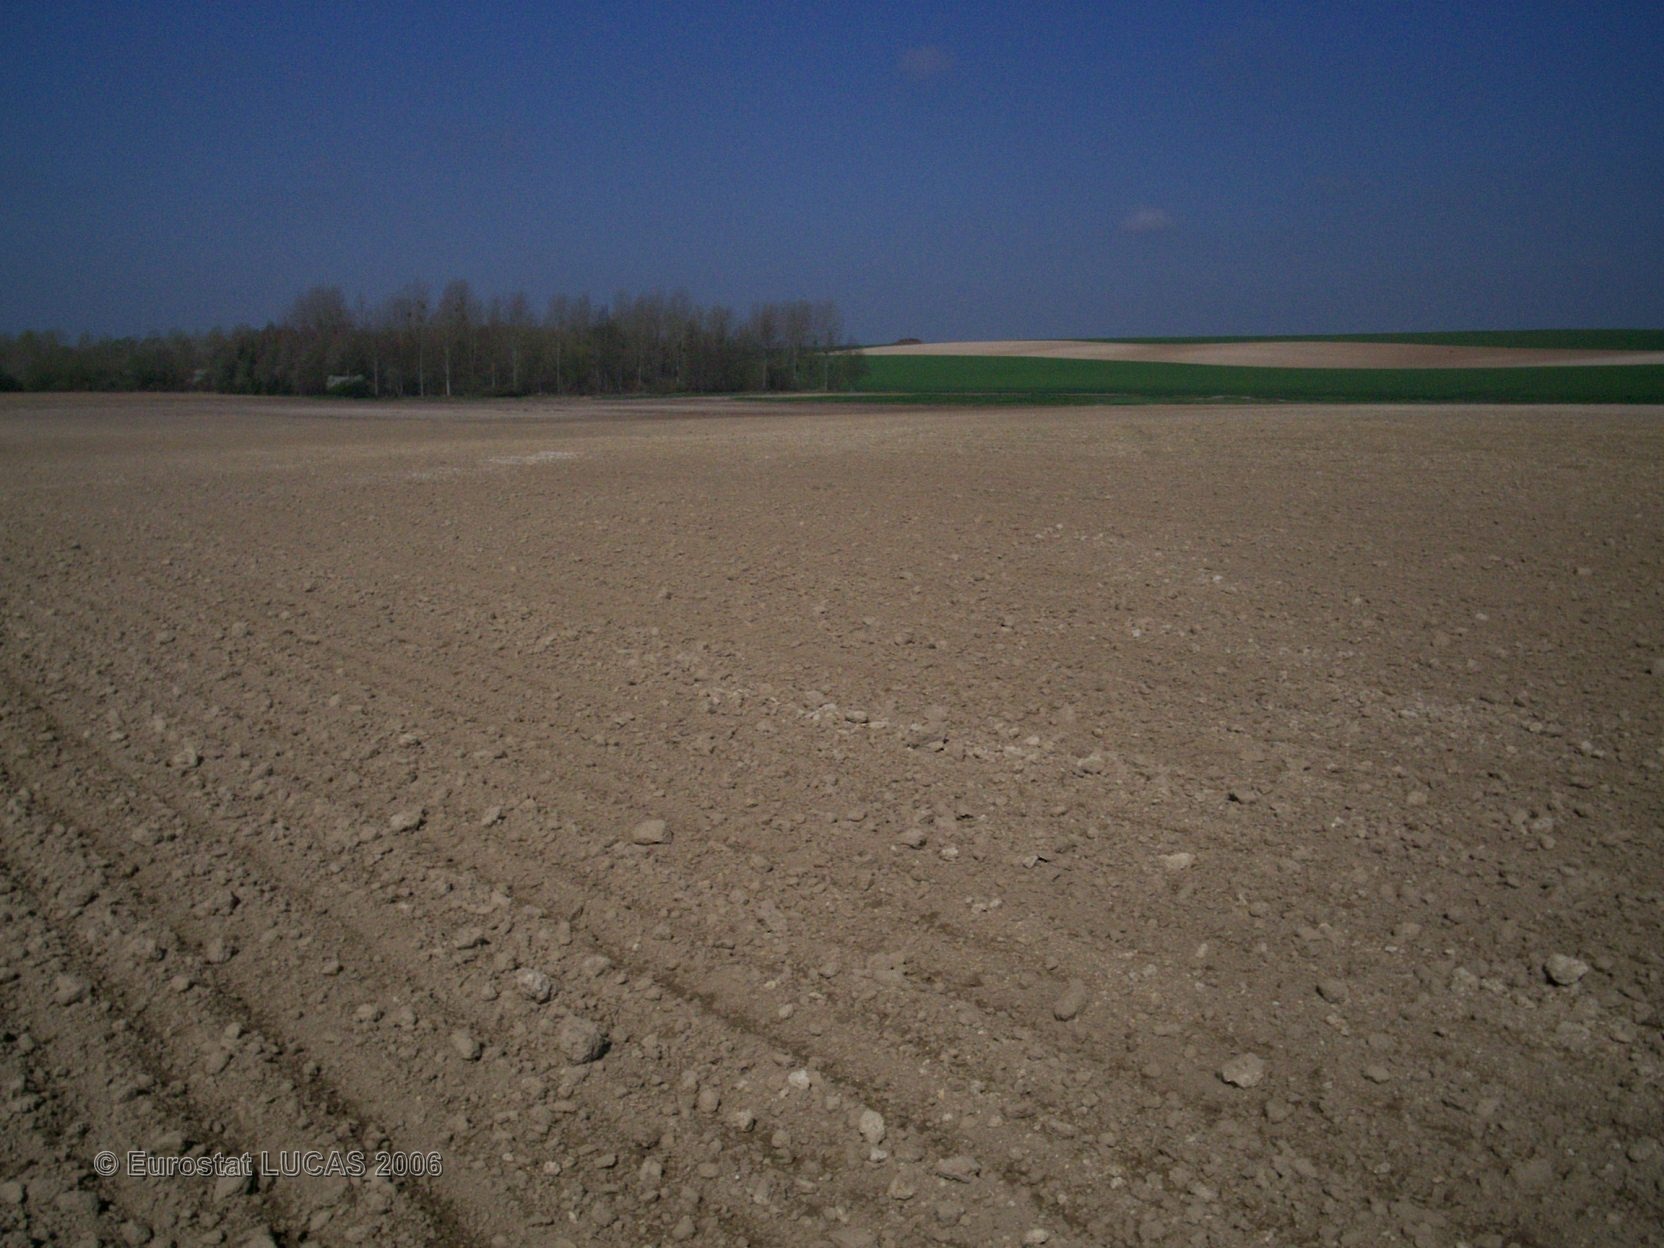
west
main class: Cropland
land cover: Other fibre and oleaginous crops
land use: Agriculture (excluding fallow land and kitchen gardens)
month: May
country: FR
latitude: 48.5377
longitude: 4.5120
